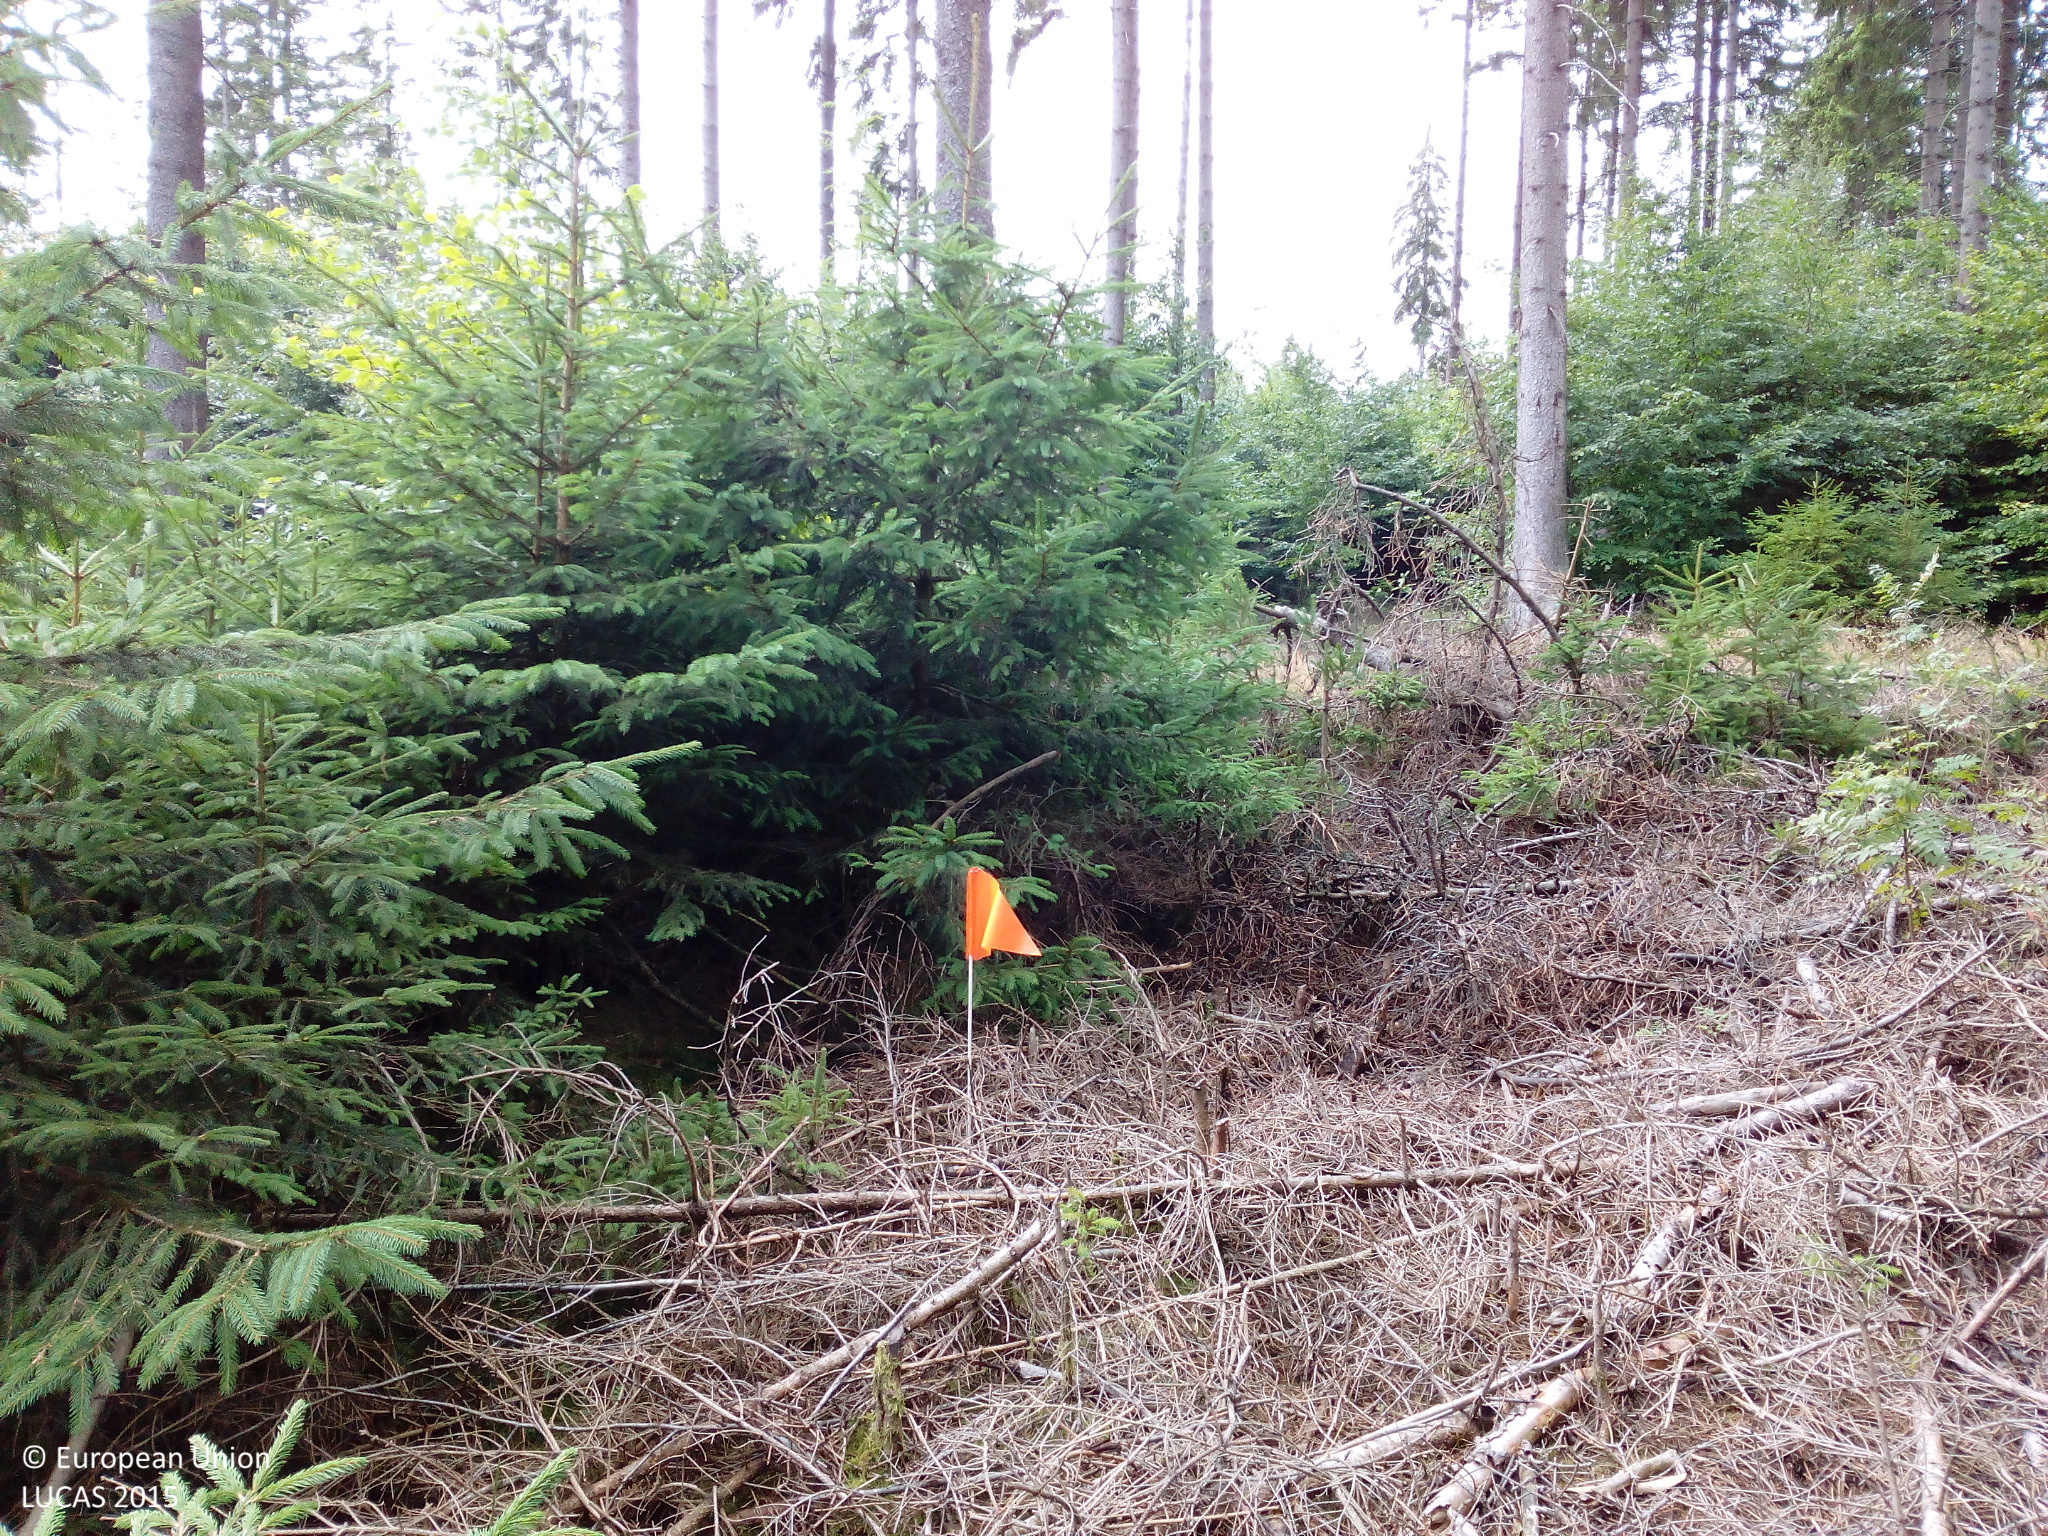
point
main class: Woodland
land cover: Spruce dominated coniferous woodland
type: hemiboreal forest and nemoral coniferous forest and mixed broadleaved-coniferous forest
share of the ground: > 75 %
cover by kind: coniferous forest trees 90 %
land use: Forestry
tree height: < 5 m
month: August
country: DE
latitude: 50.3890
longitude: 11.5890
